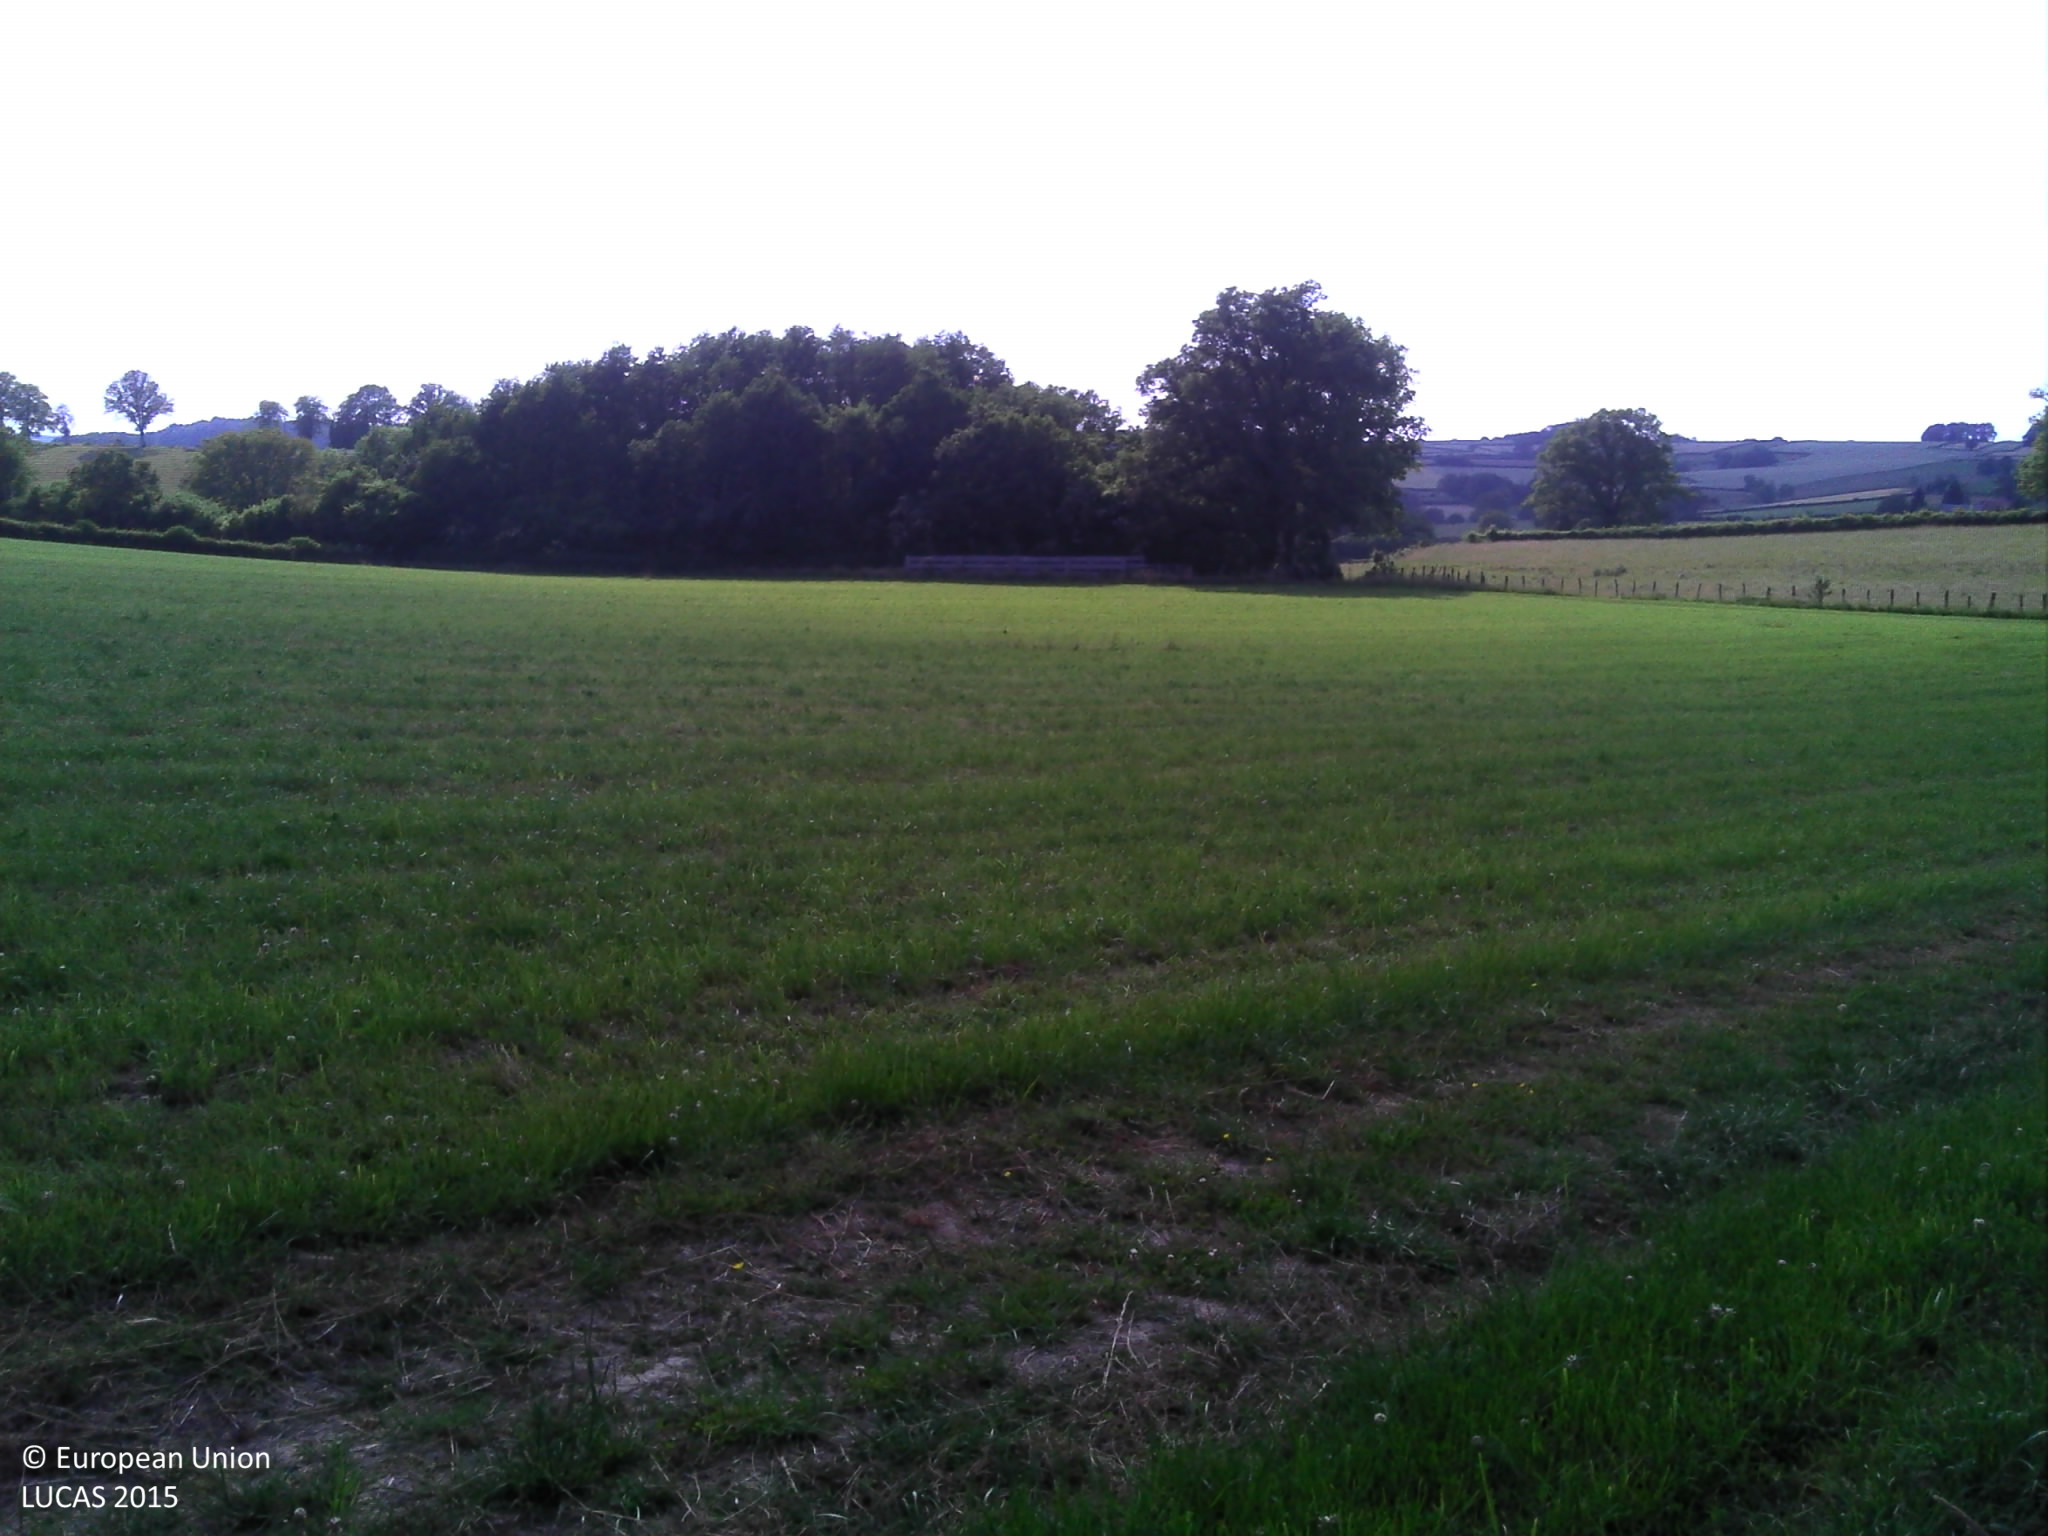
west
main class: Grassland
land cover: Grassland without tree/shrub cover
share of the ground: > 75 %
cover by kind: herbaceous plants 100 %
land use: Agriculture (excluding fallow land and kitchen gardens)
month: June
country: FR
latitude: 47.3908
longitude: 3.9702
